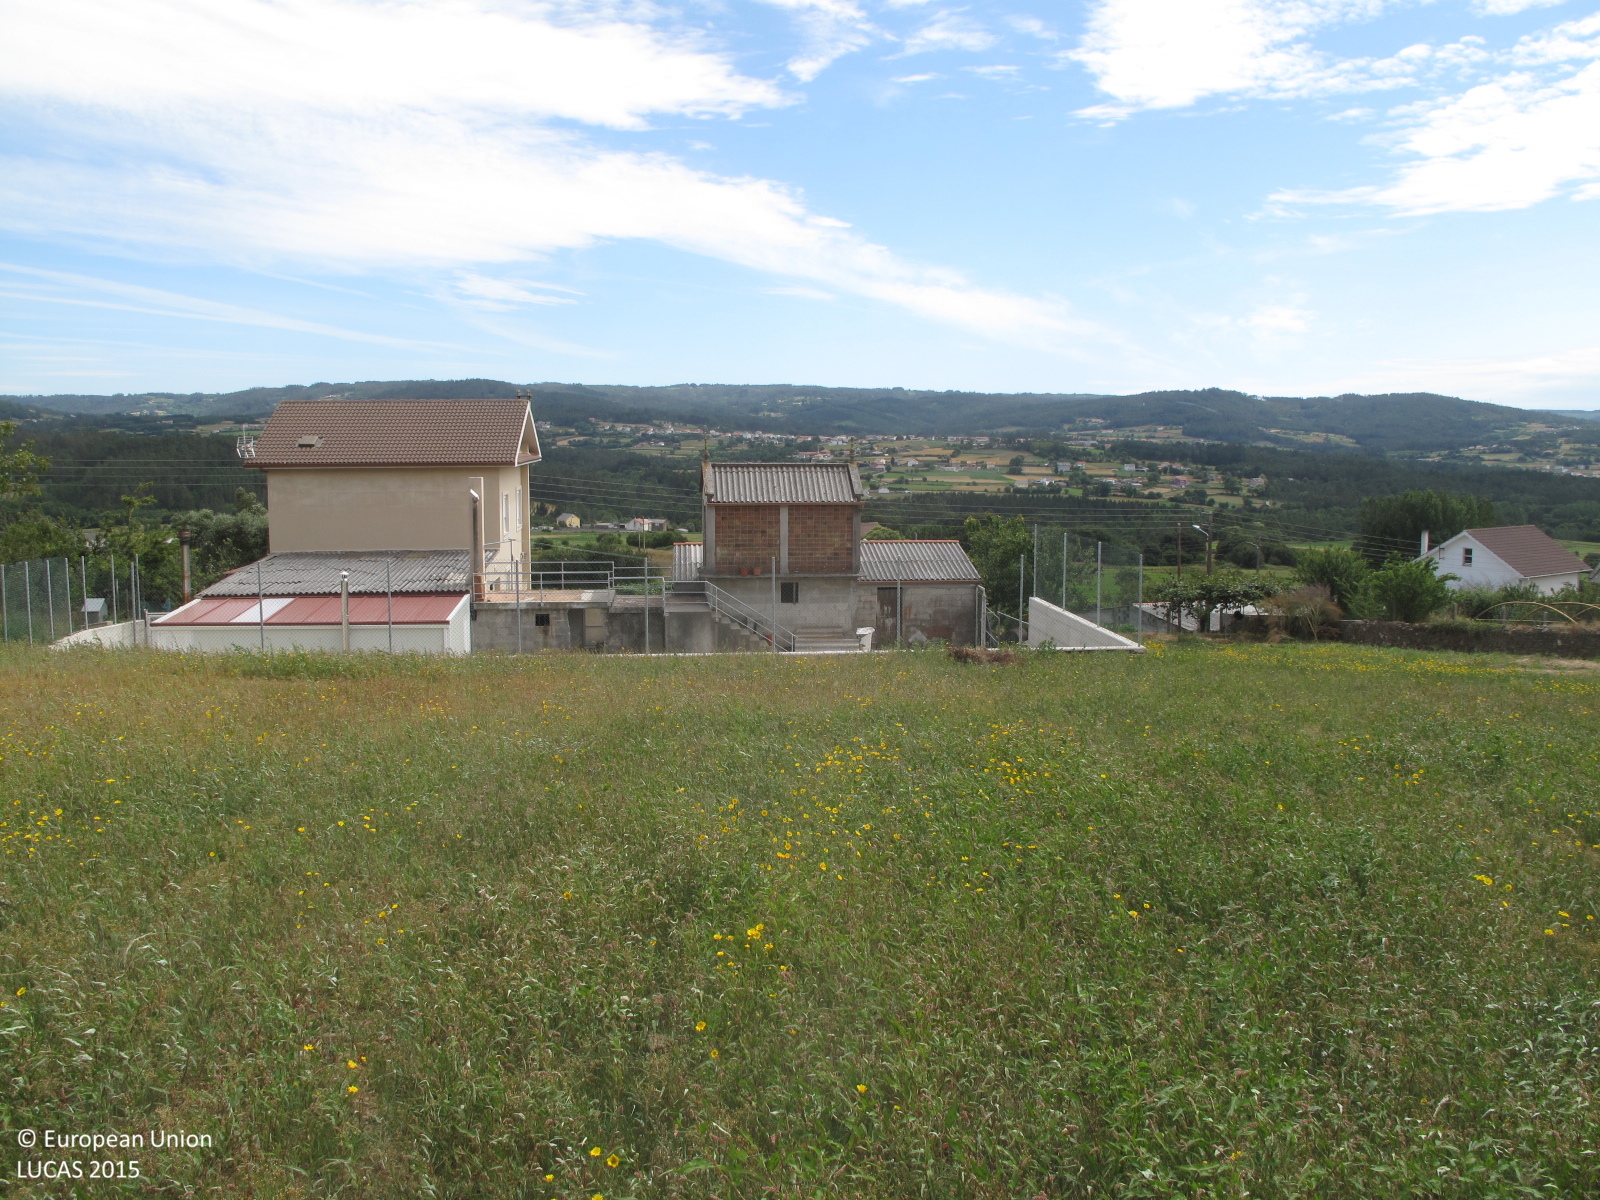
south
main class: Grassland
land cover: Spontaneously vegetated surfaces
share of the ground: 50 - 75 %
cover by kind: herbaceous plants 70 %, unconsolidated bare surface 30 %
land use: Fallow land
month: July
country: ES
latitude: 43.2160
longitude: -8.6387
